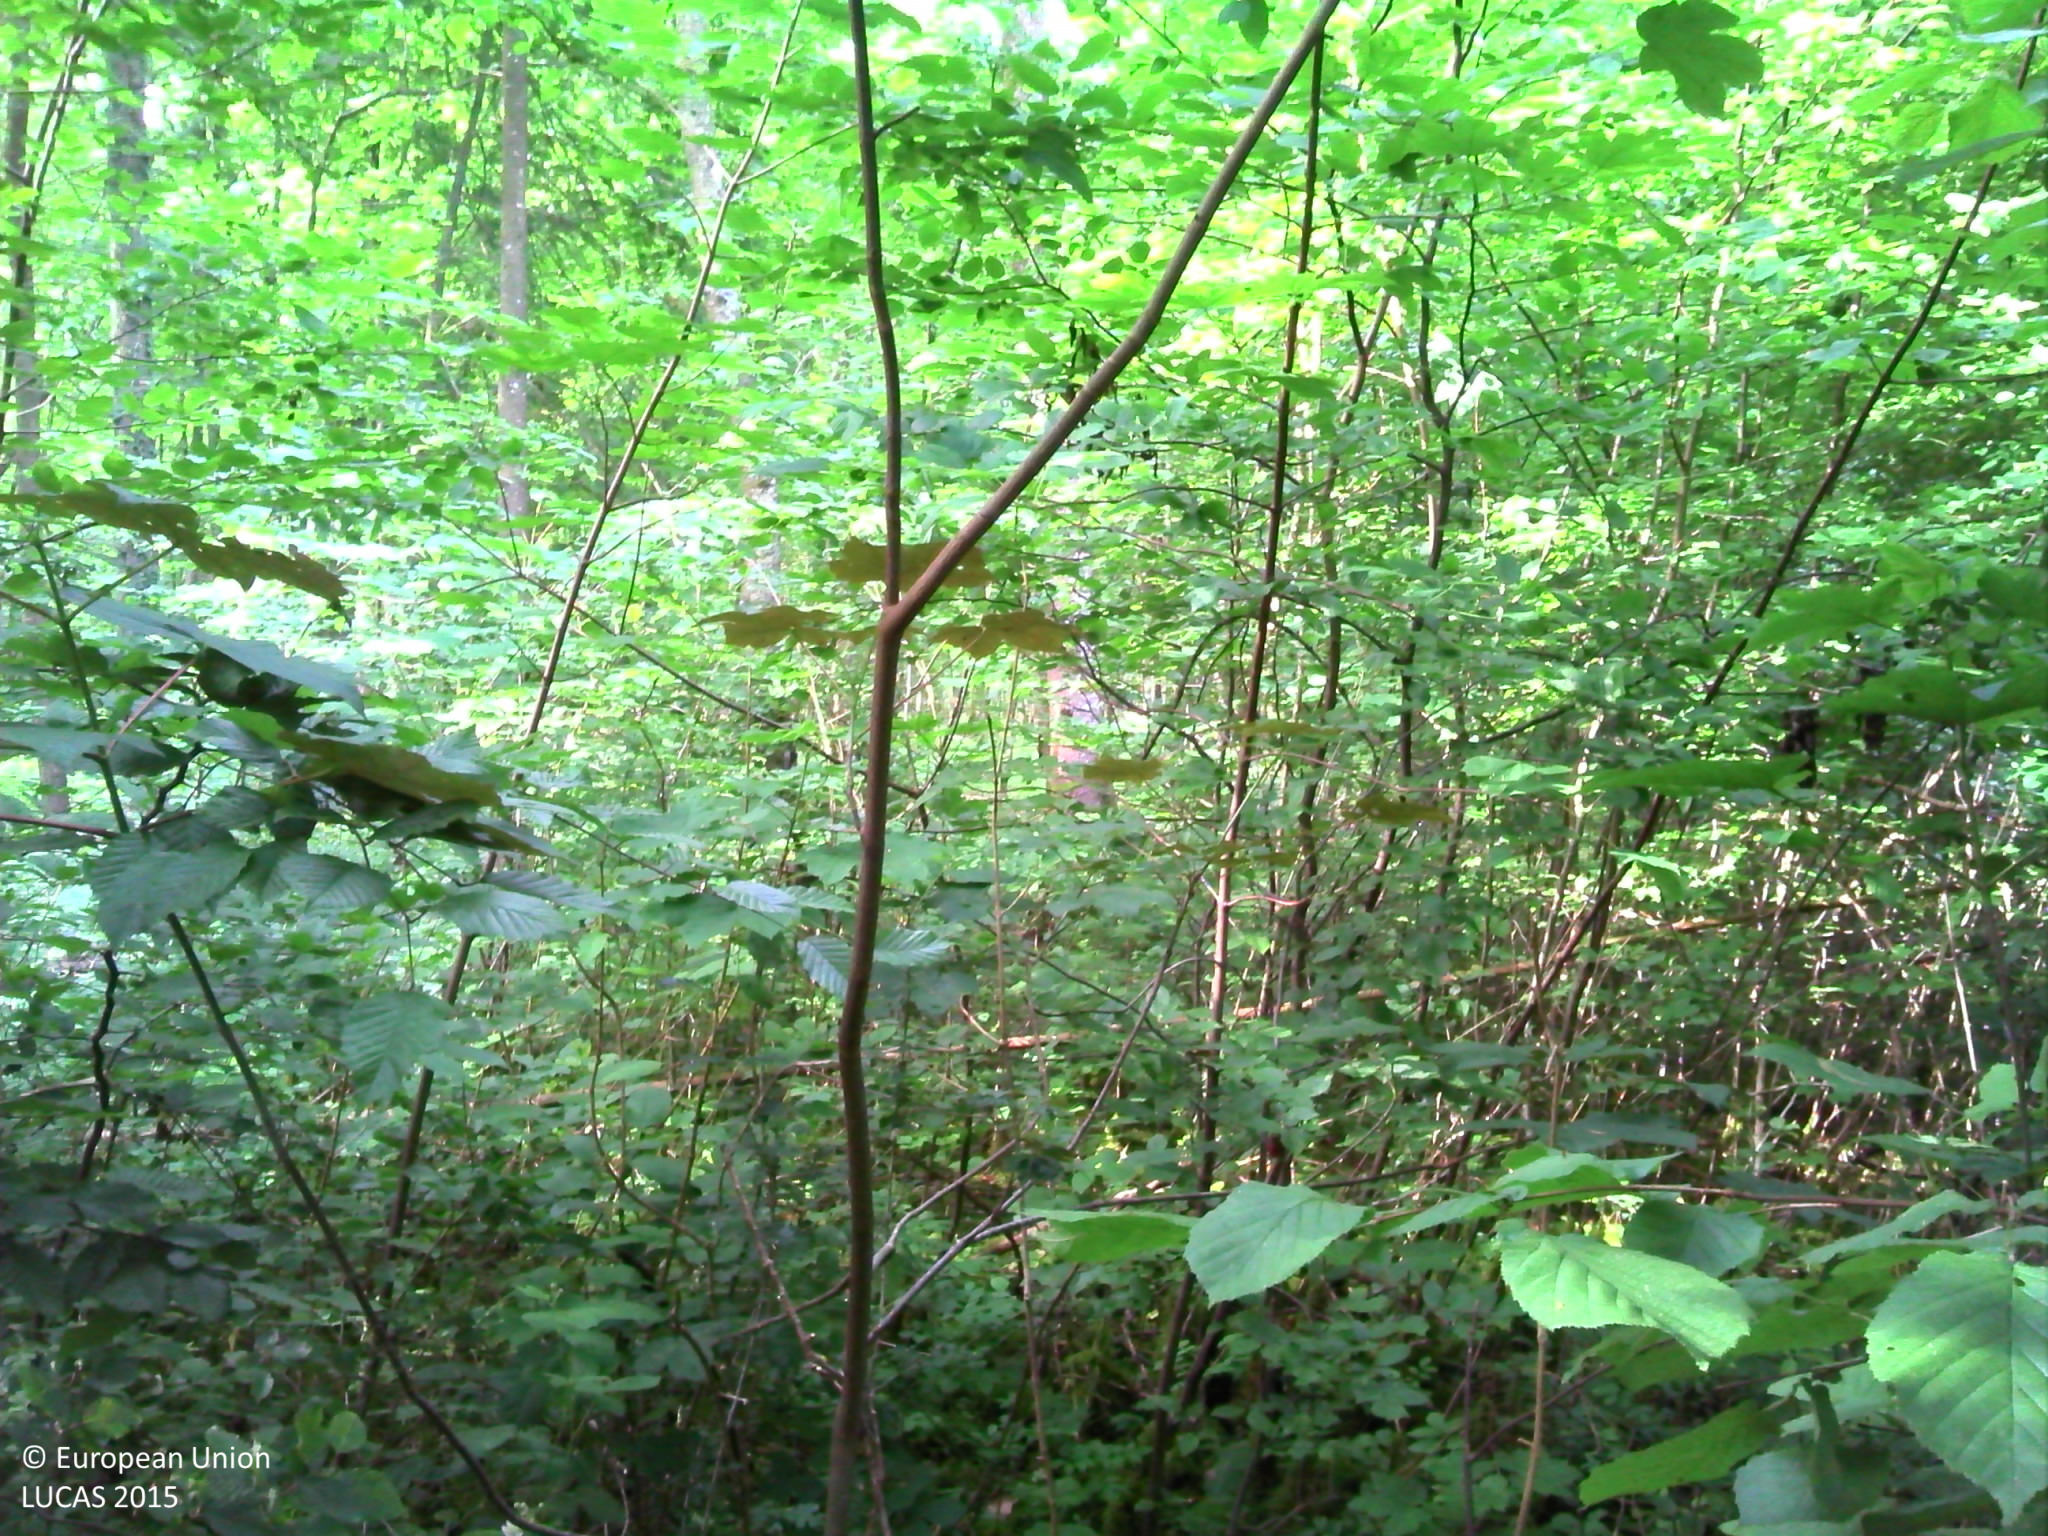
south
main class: Woodland
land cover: Broadleaved woodland
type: mesophytic deciduous forest
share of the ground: > 75 %
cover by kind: broadleaved forest trees 100 %
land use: Forestry
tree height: > 5 m
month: June
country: BE
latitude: 50.1037
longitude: 5.2582
